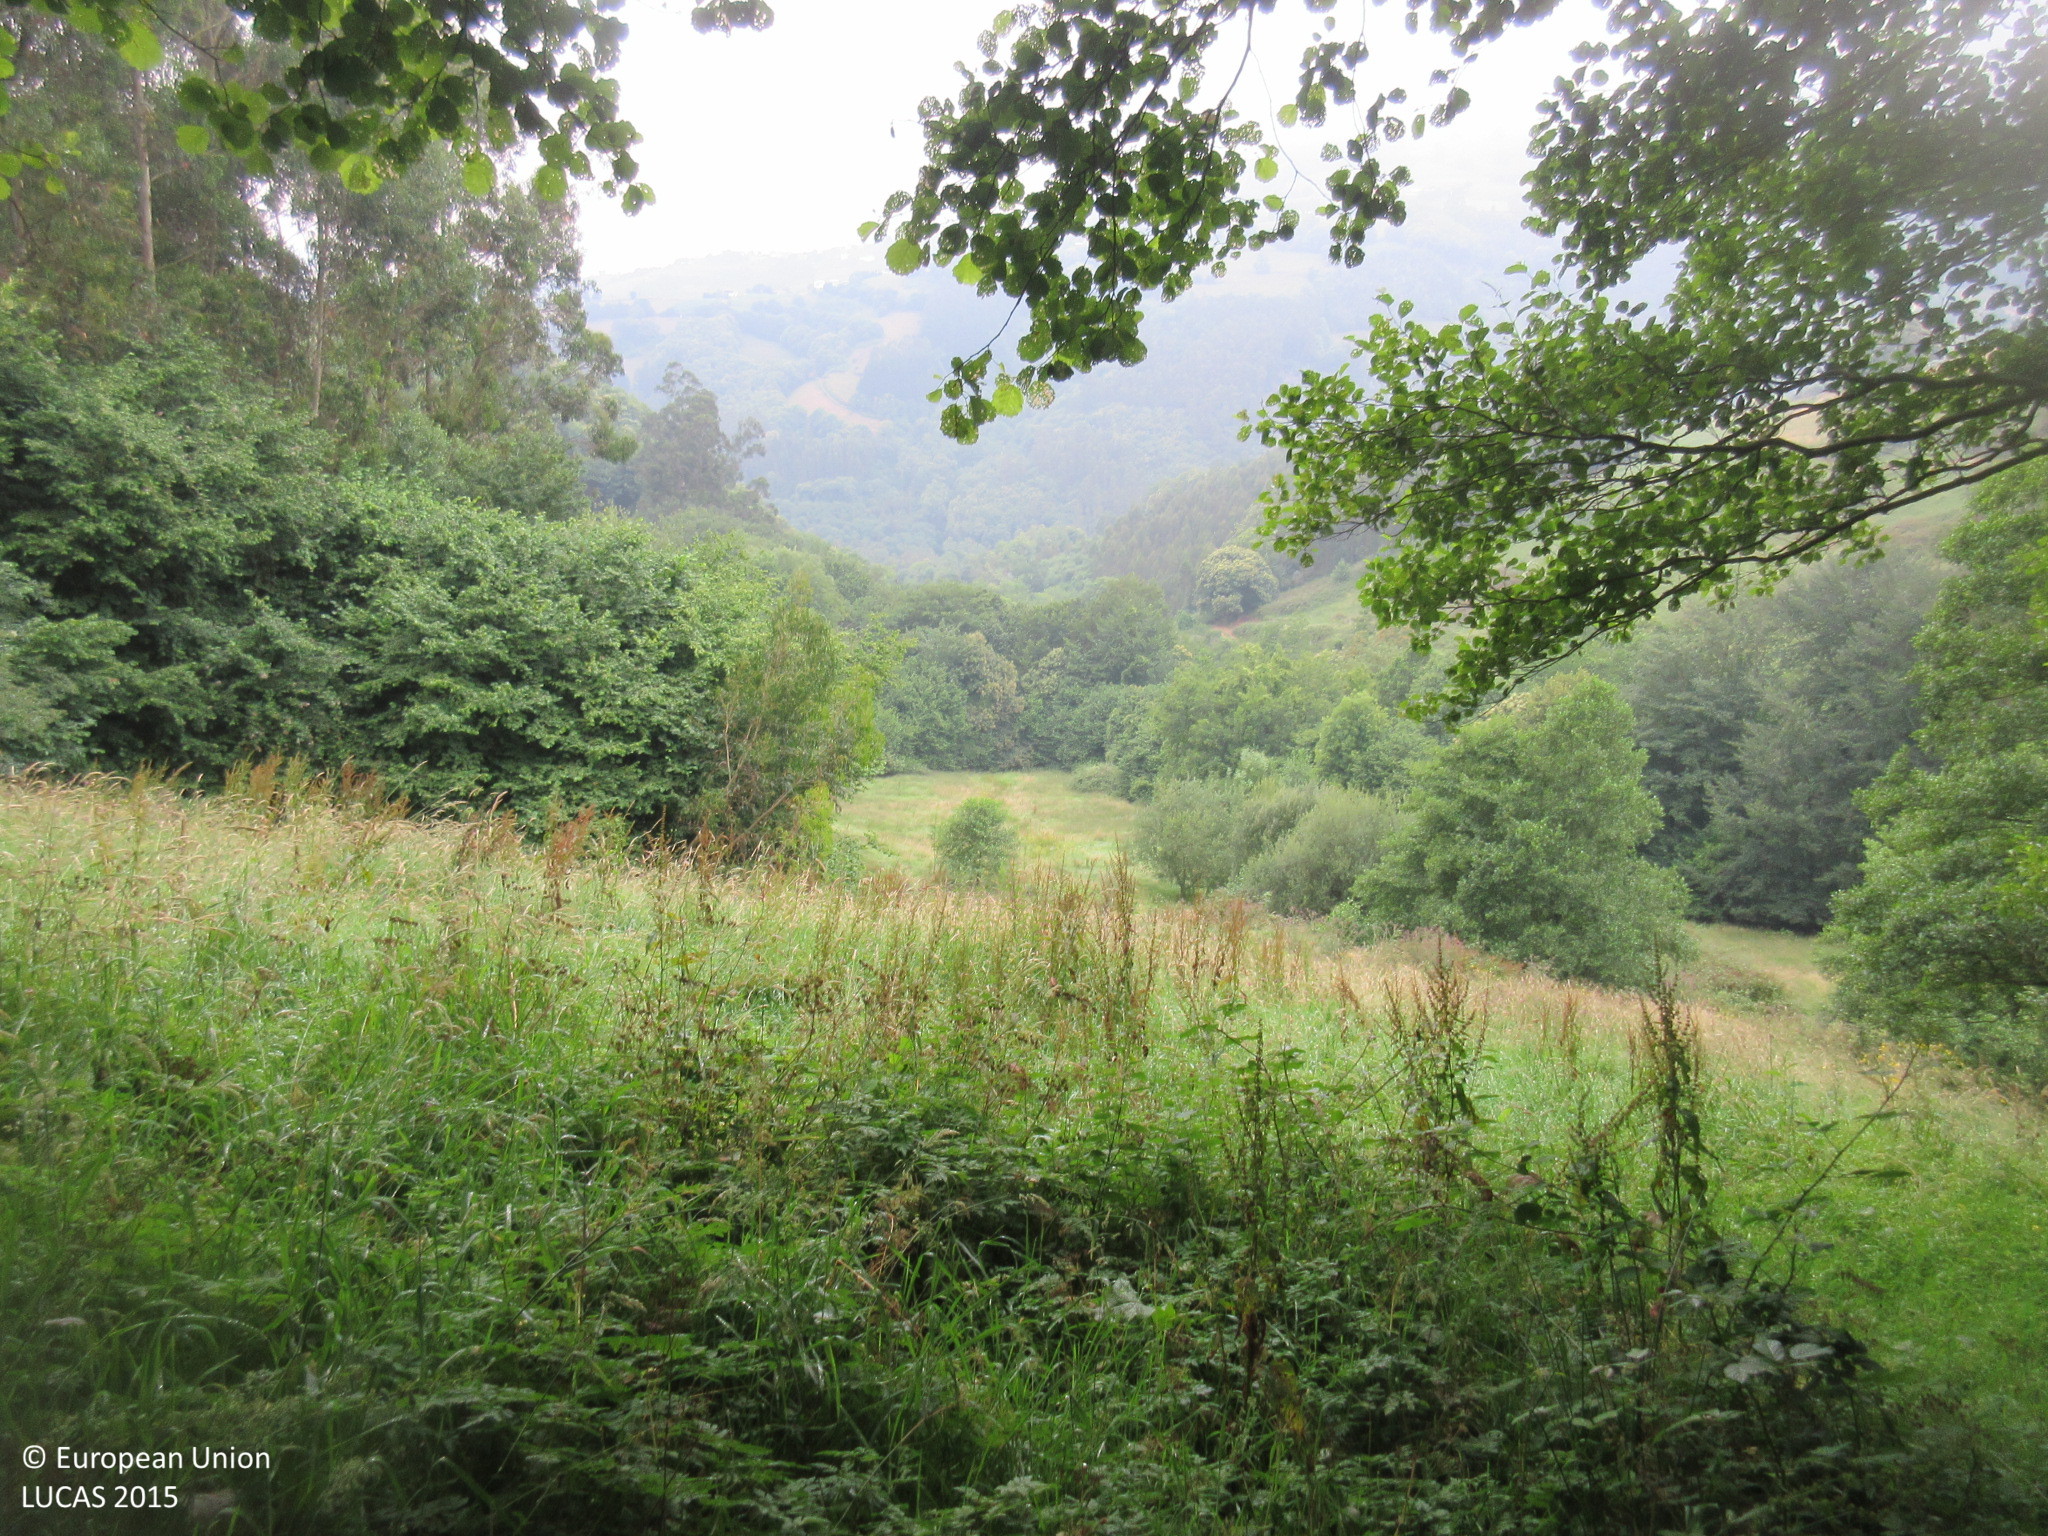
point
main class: Grassland
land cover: Grassland without tree/shrub cover
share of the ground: > 75 %
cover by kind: herbaceous plants 100 %
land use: Agriculture (excluding fallow land and kitchen gardens)
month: July
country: ES
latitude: 43.4338
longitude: -6.3203
